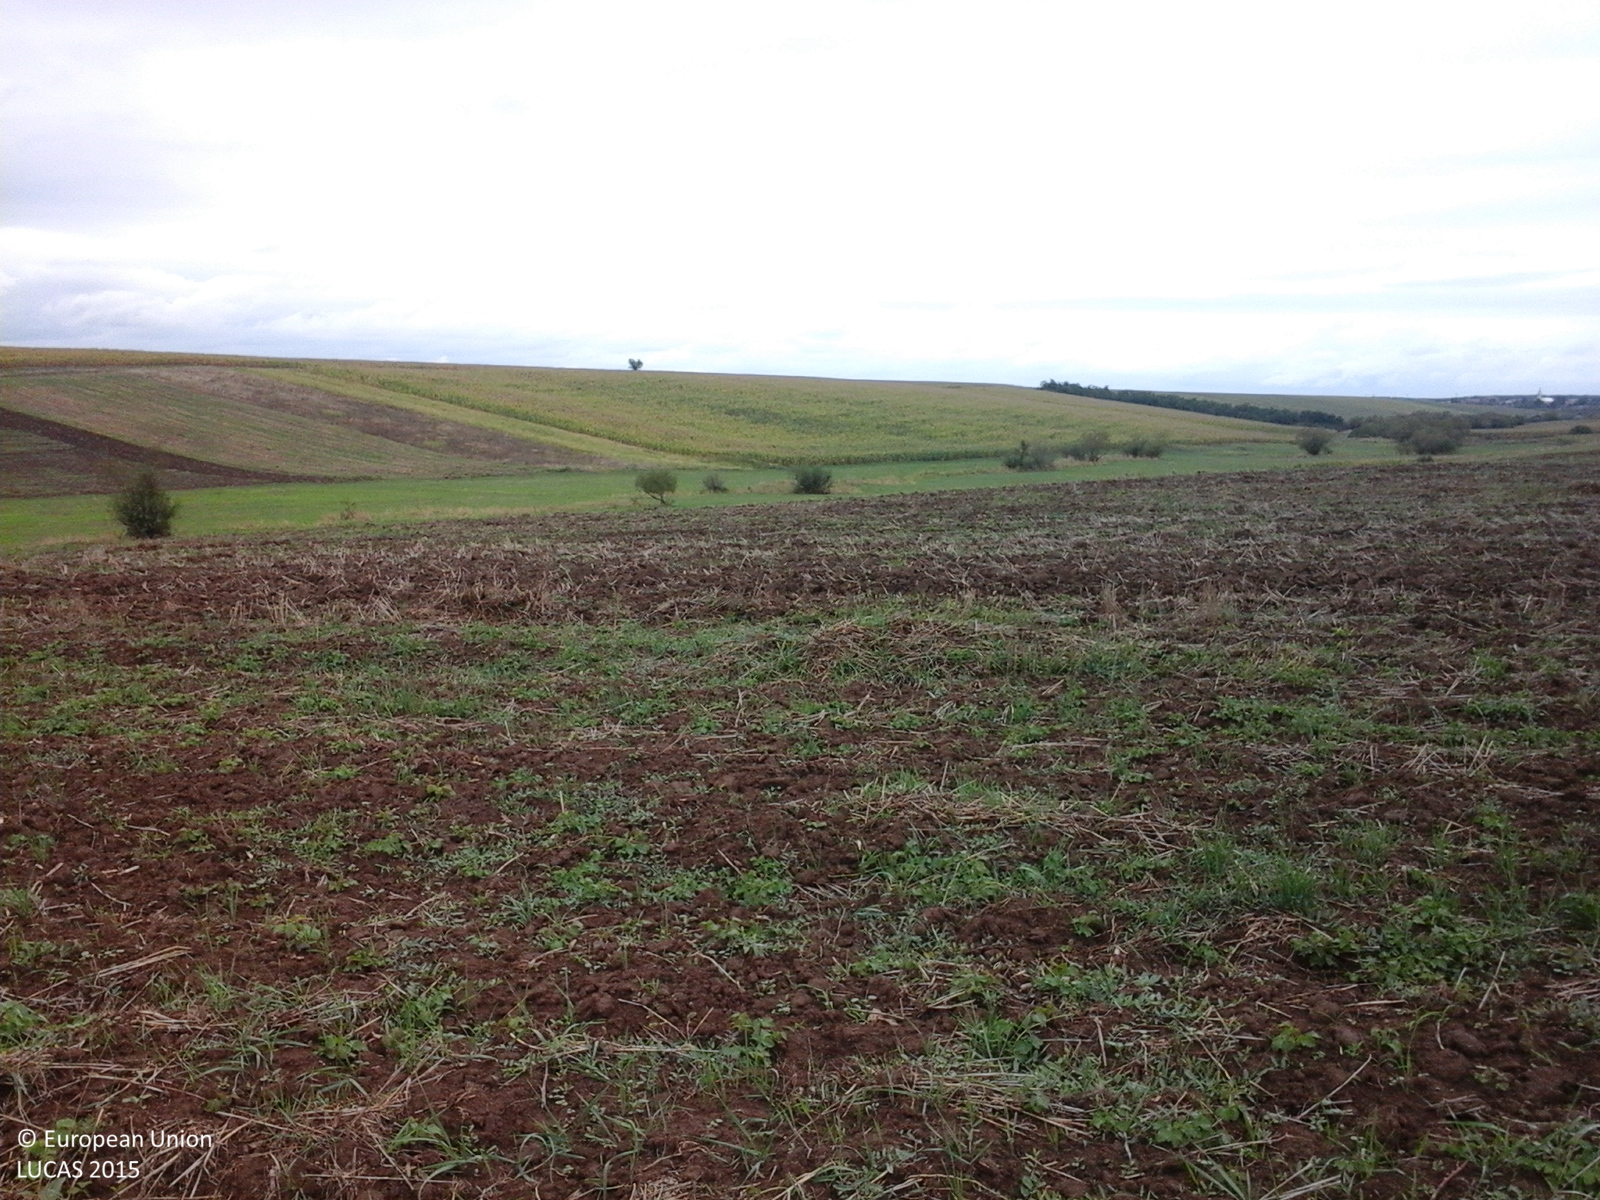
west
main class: Cropland
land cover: Common wheat
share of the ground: < 10 %
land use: Agriculture (excluding fallow land and kitchen gardens)
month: September
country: RO
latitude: 46.8708
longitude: 21.8652
